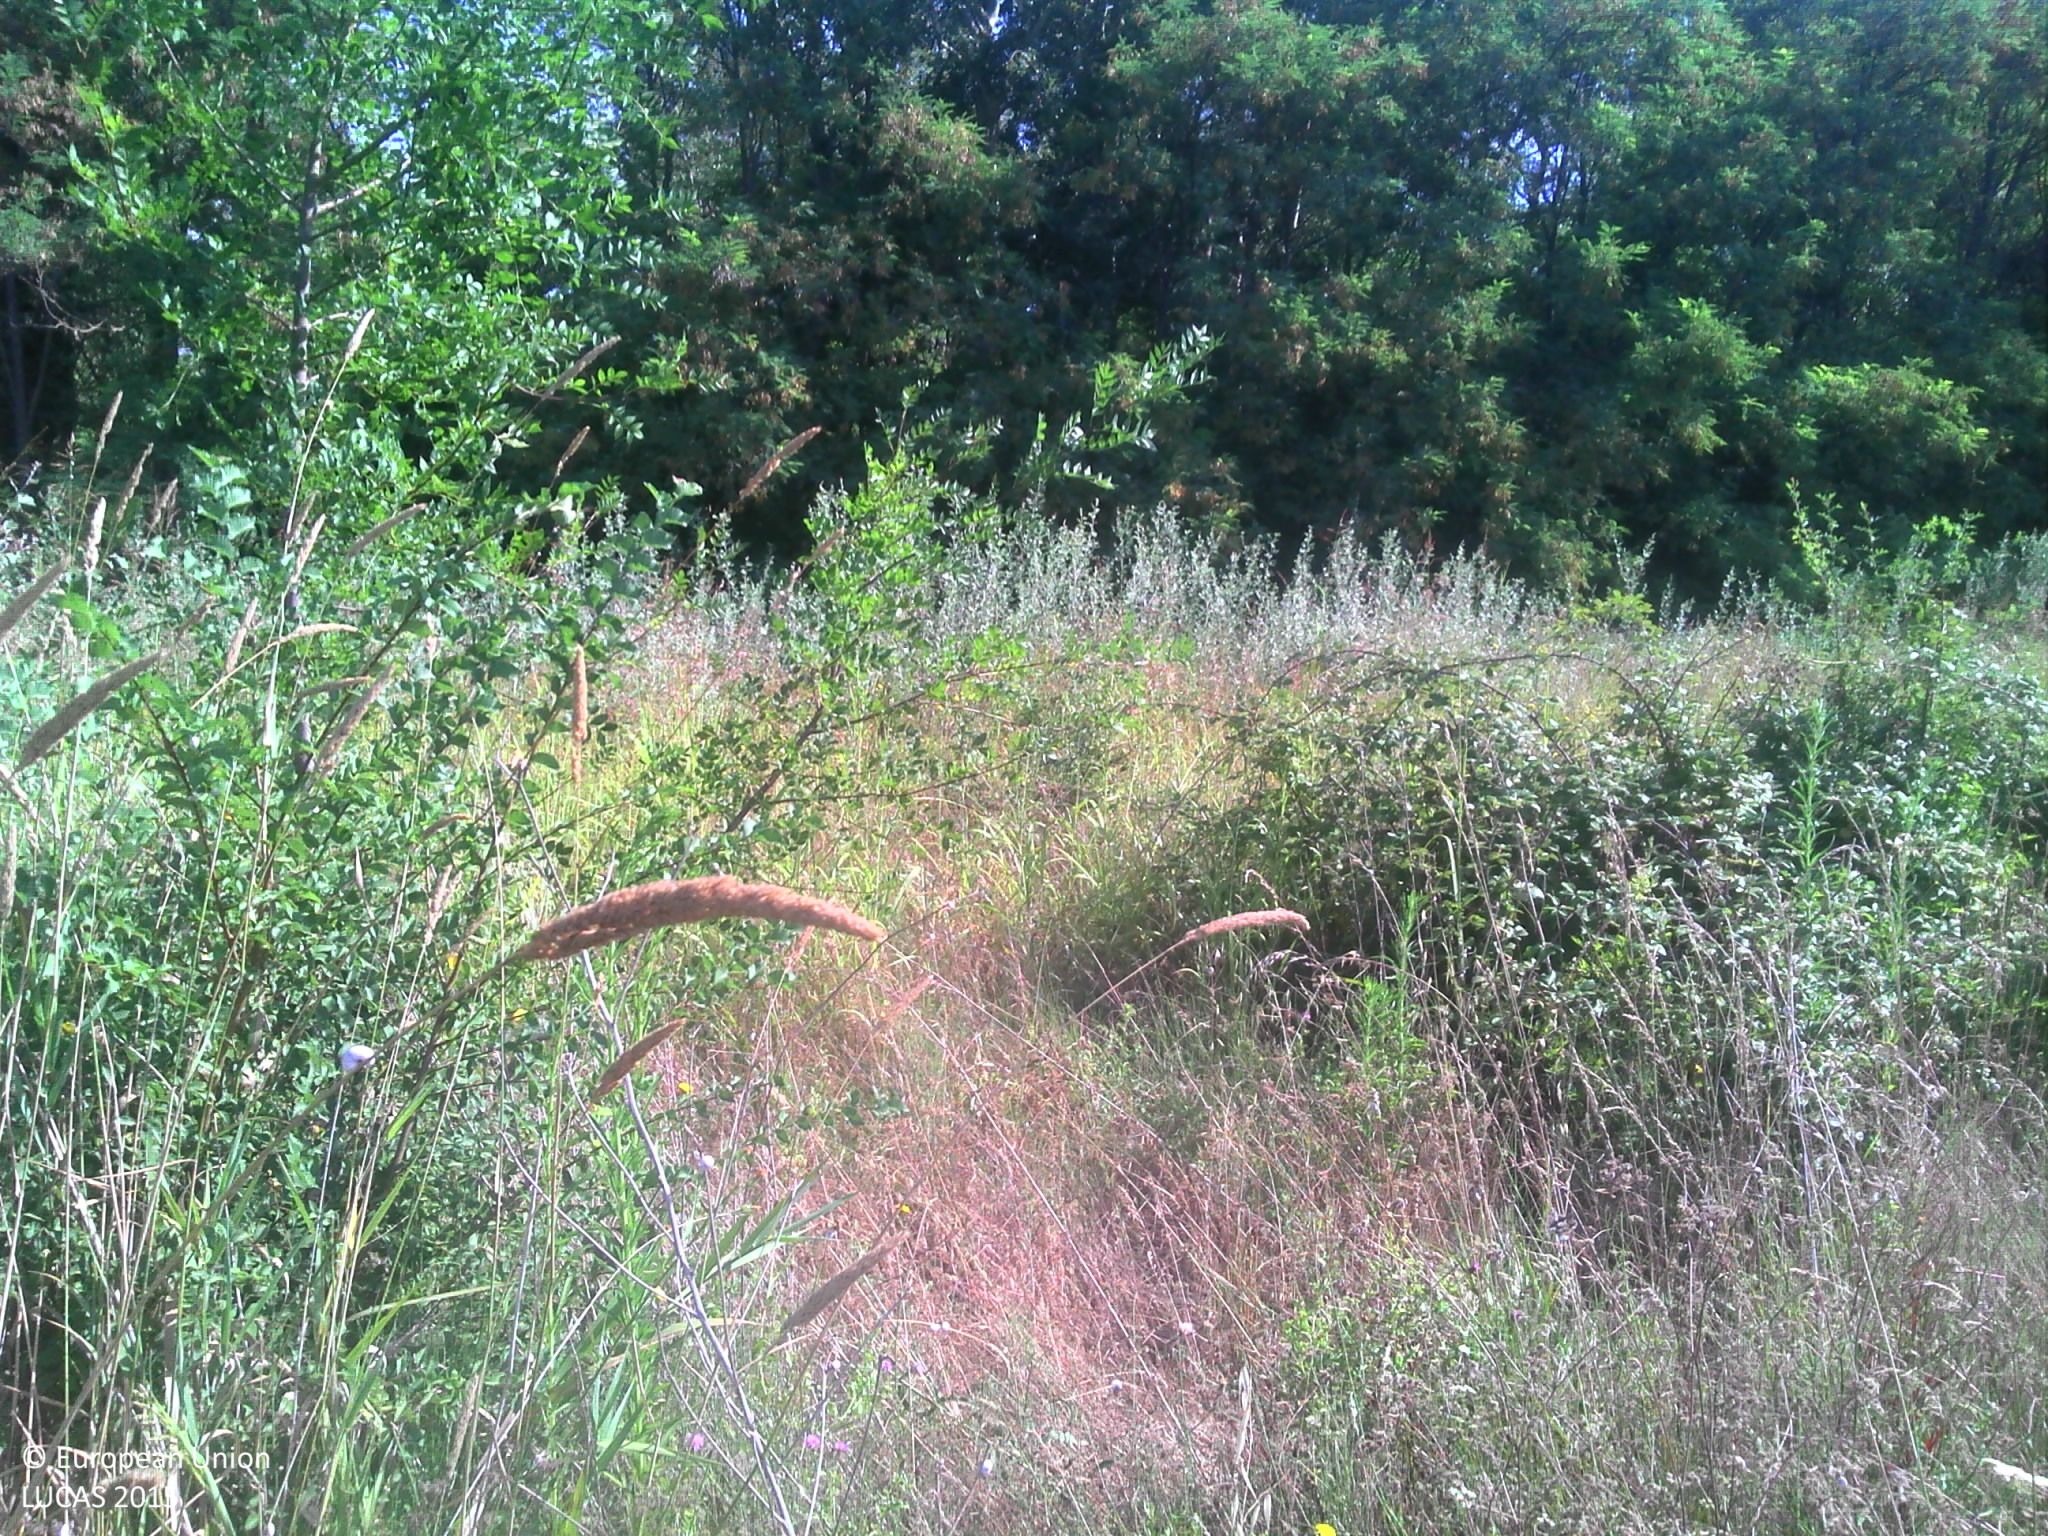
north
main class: Grassland
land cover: Grassland with sparse tree/shrub cover
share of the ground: > 75 %
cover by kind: herbaceous plants 85 %, broadleaved forest trees 5 %, shrubs 5 %, consolidated bare surface 5 %
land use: Fallow land
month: July
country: FR
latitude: 43.7372
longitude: 5.2786
